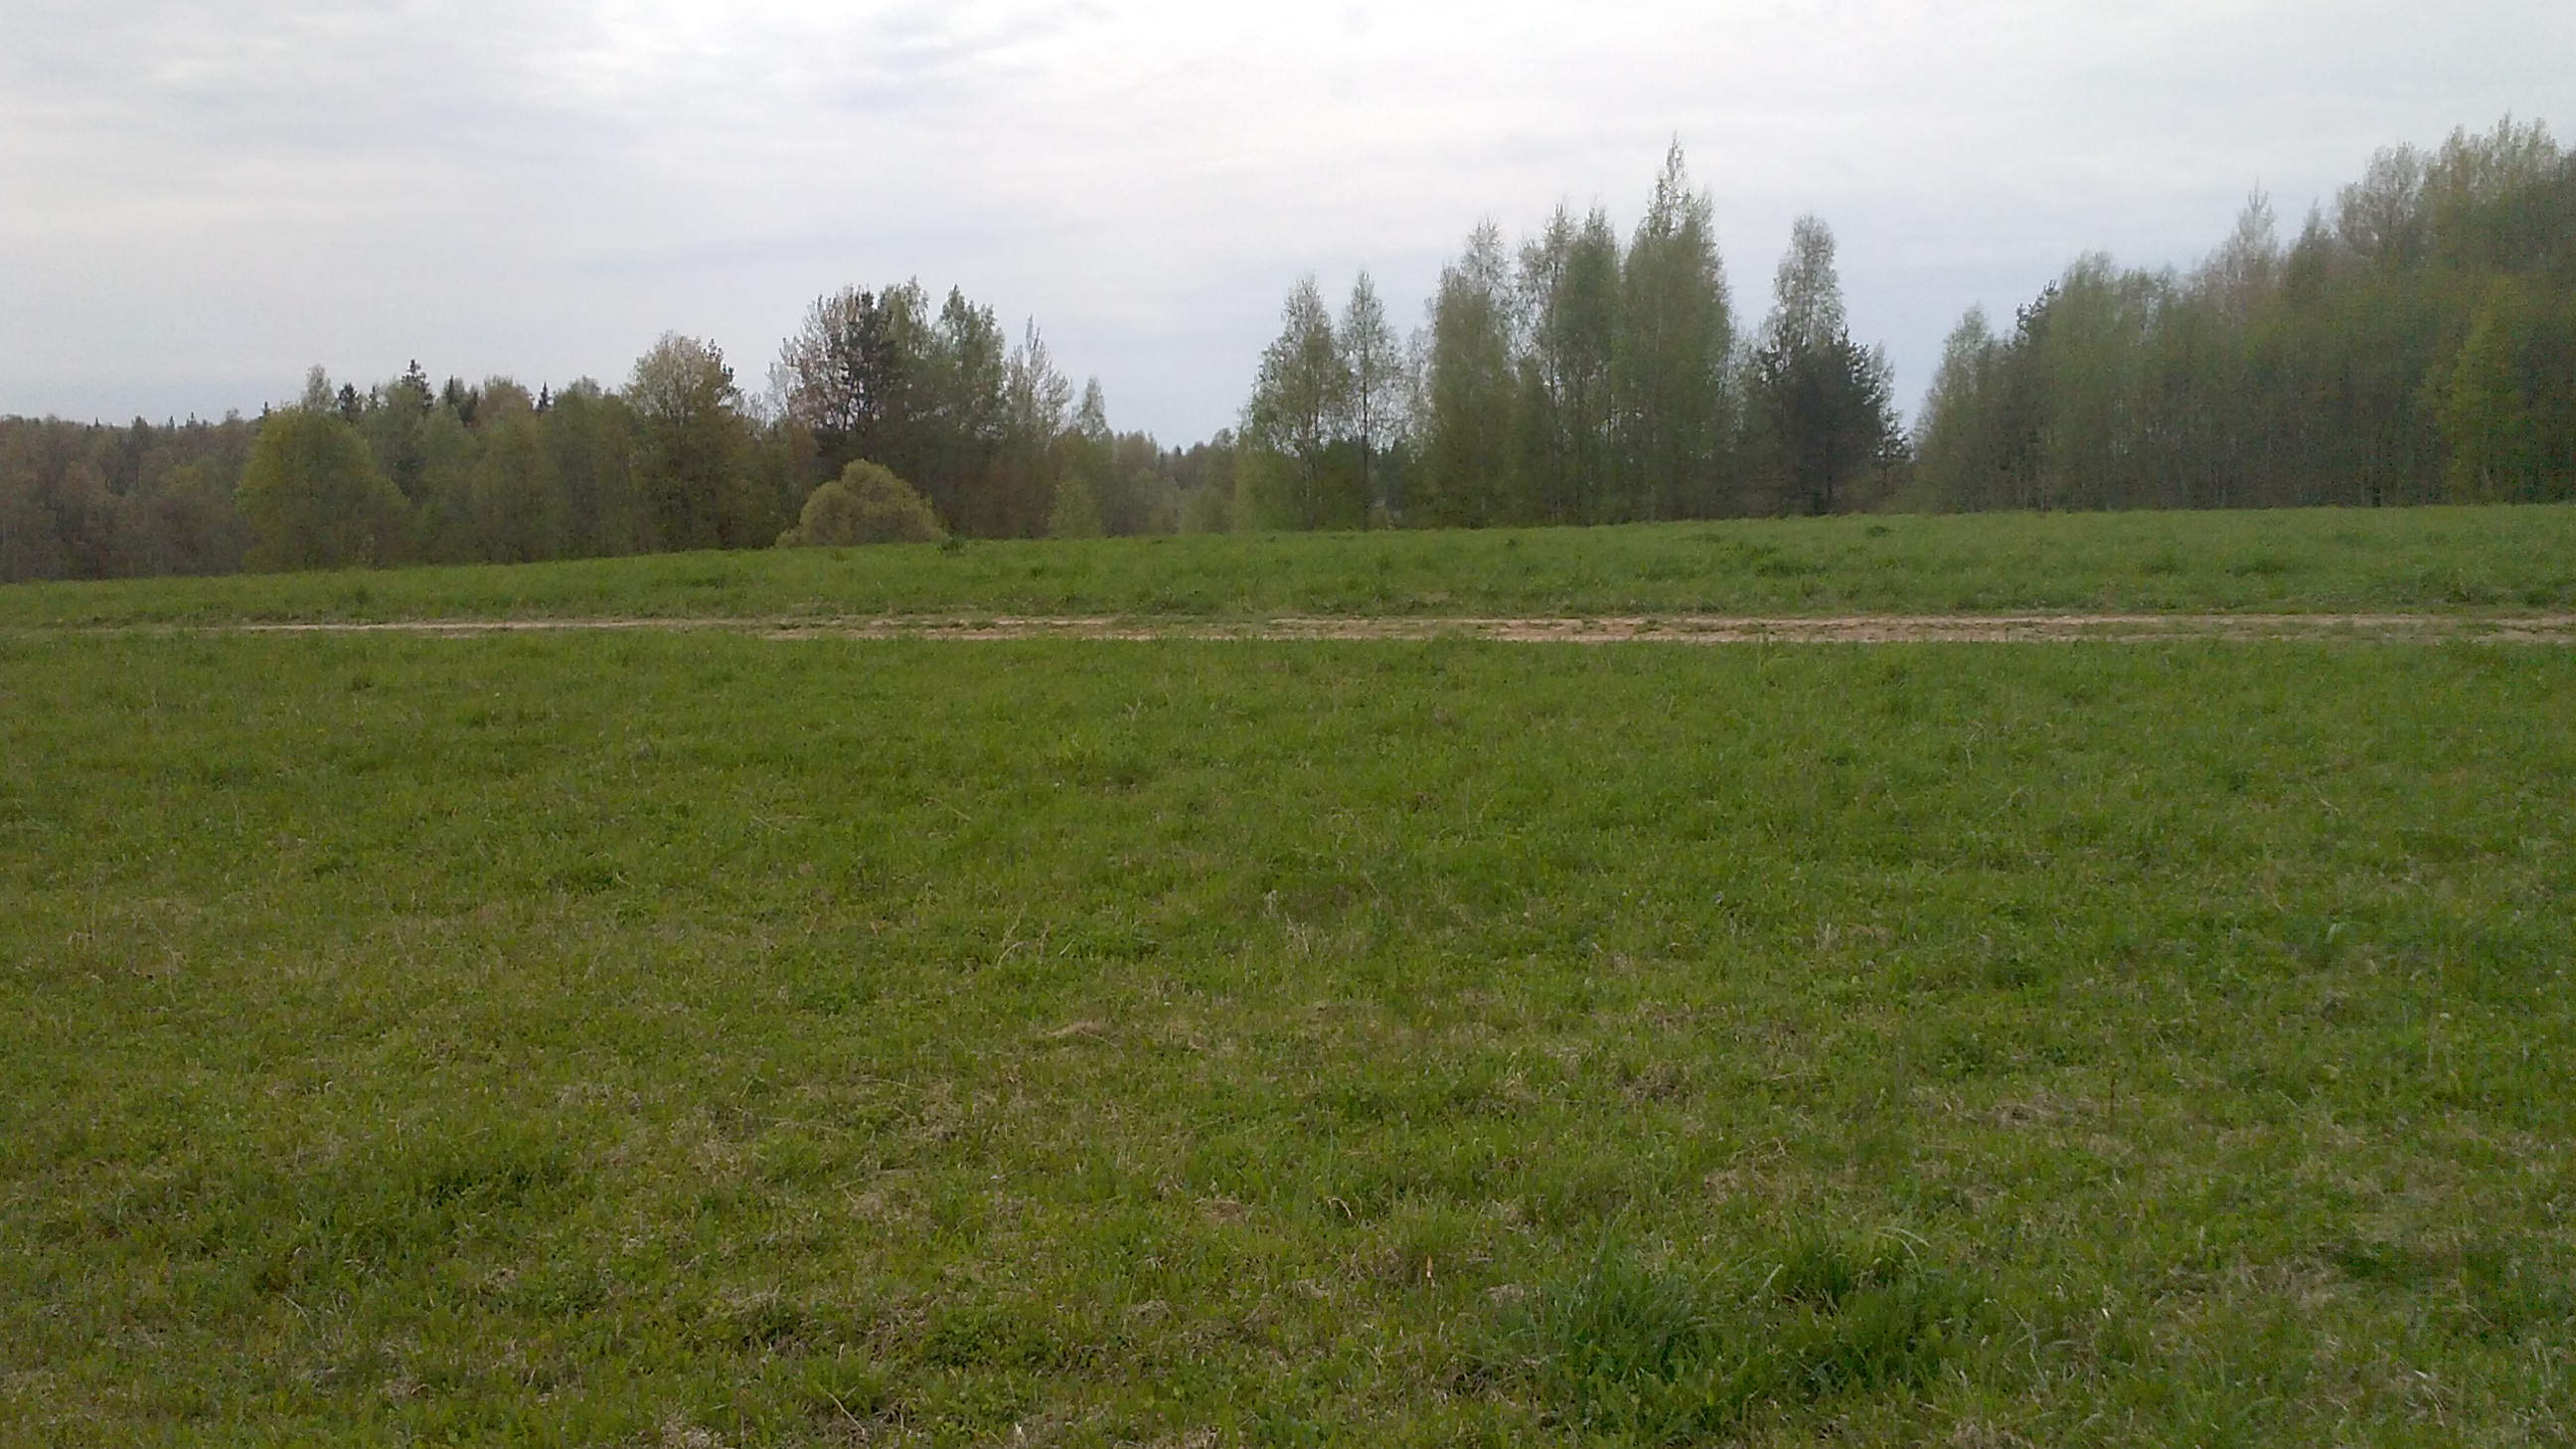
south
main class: Grassland
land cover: Grassland without tree/shrub cover
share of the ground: > 75 %
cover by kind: herbaceous plants 100 %
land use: Agriculture (excluding fallow land and kitchen gardens)
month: May
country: LV
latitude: 55.9579
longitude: 27.1652
